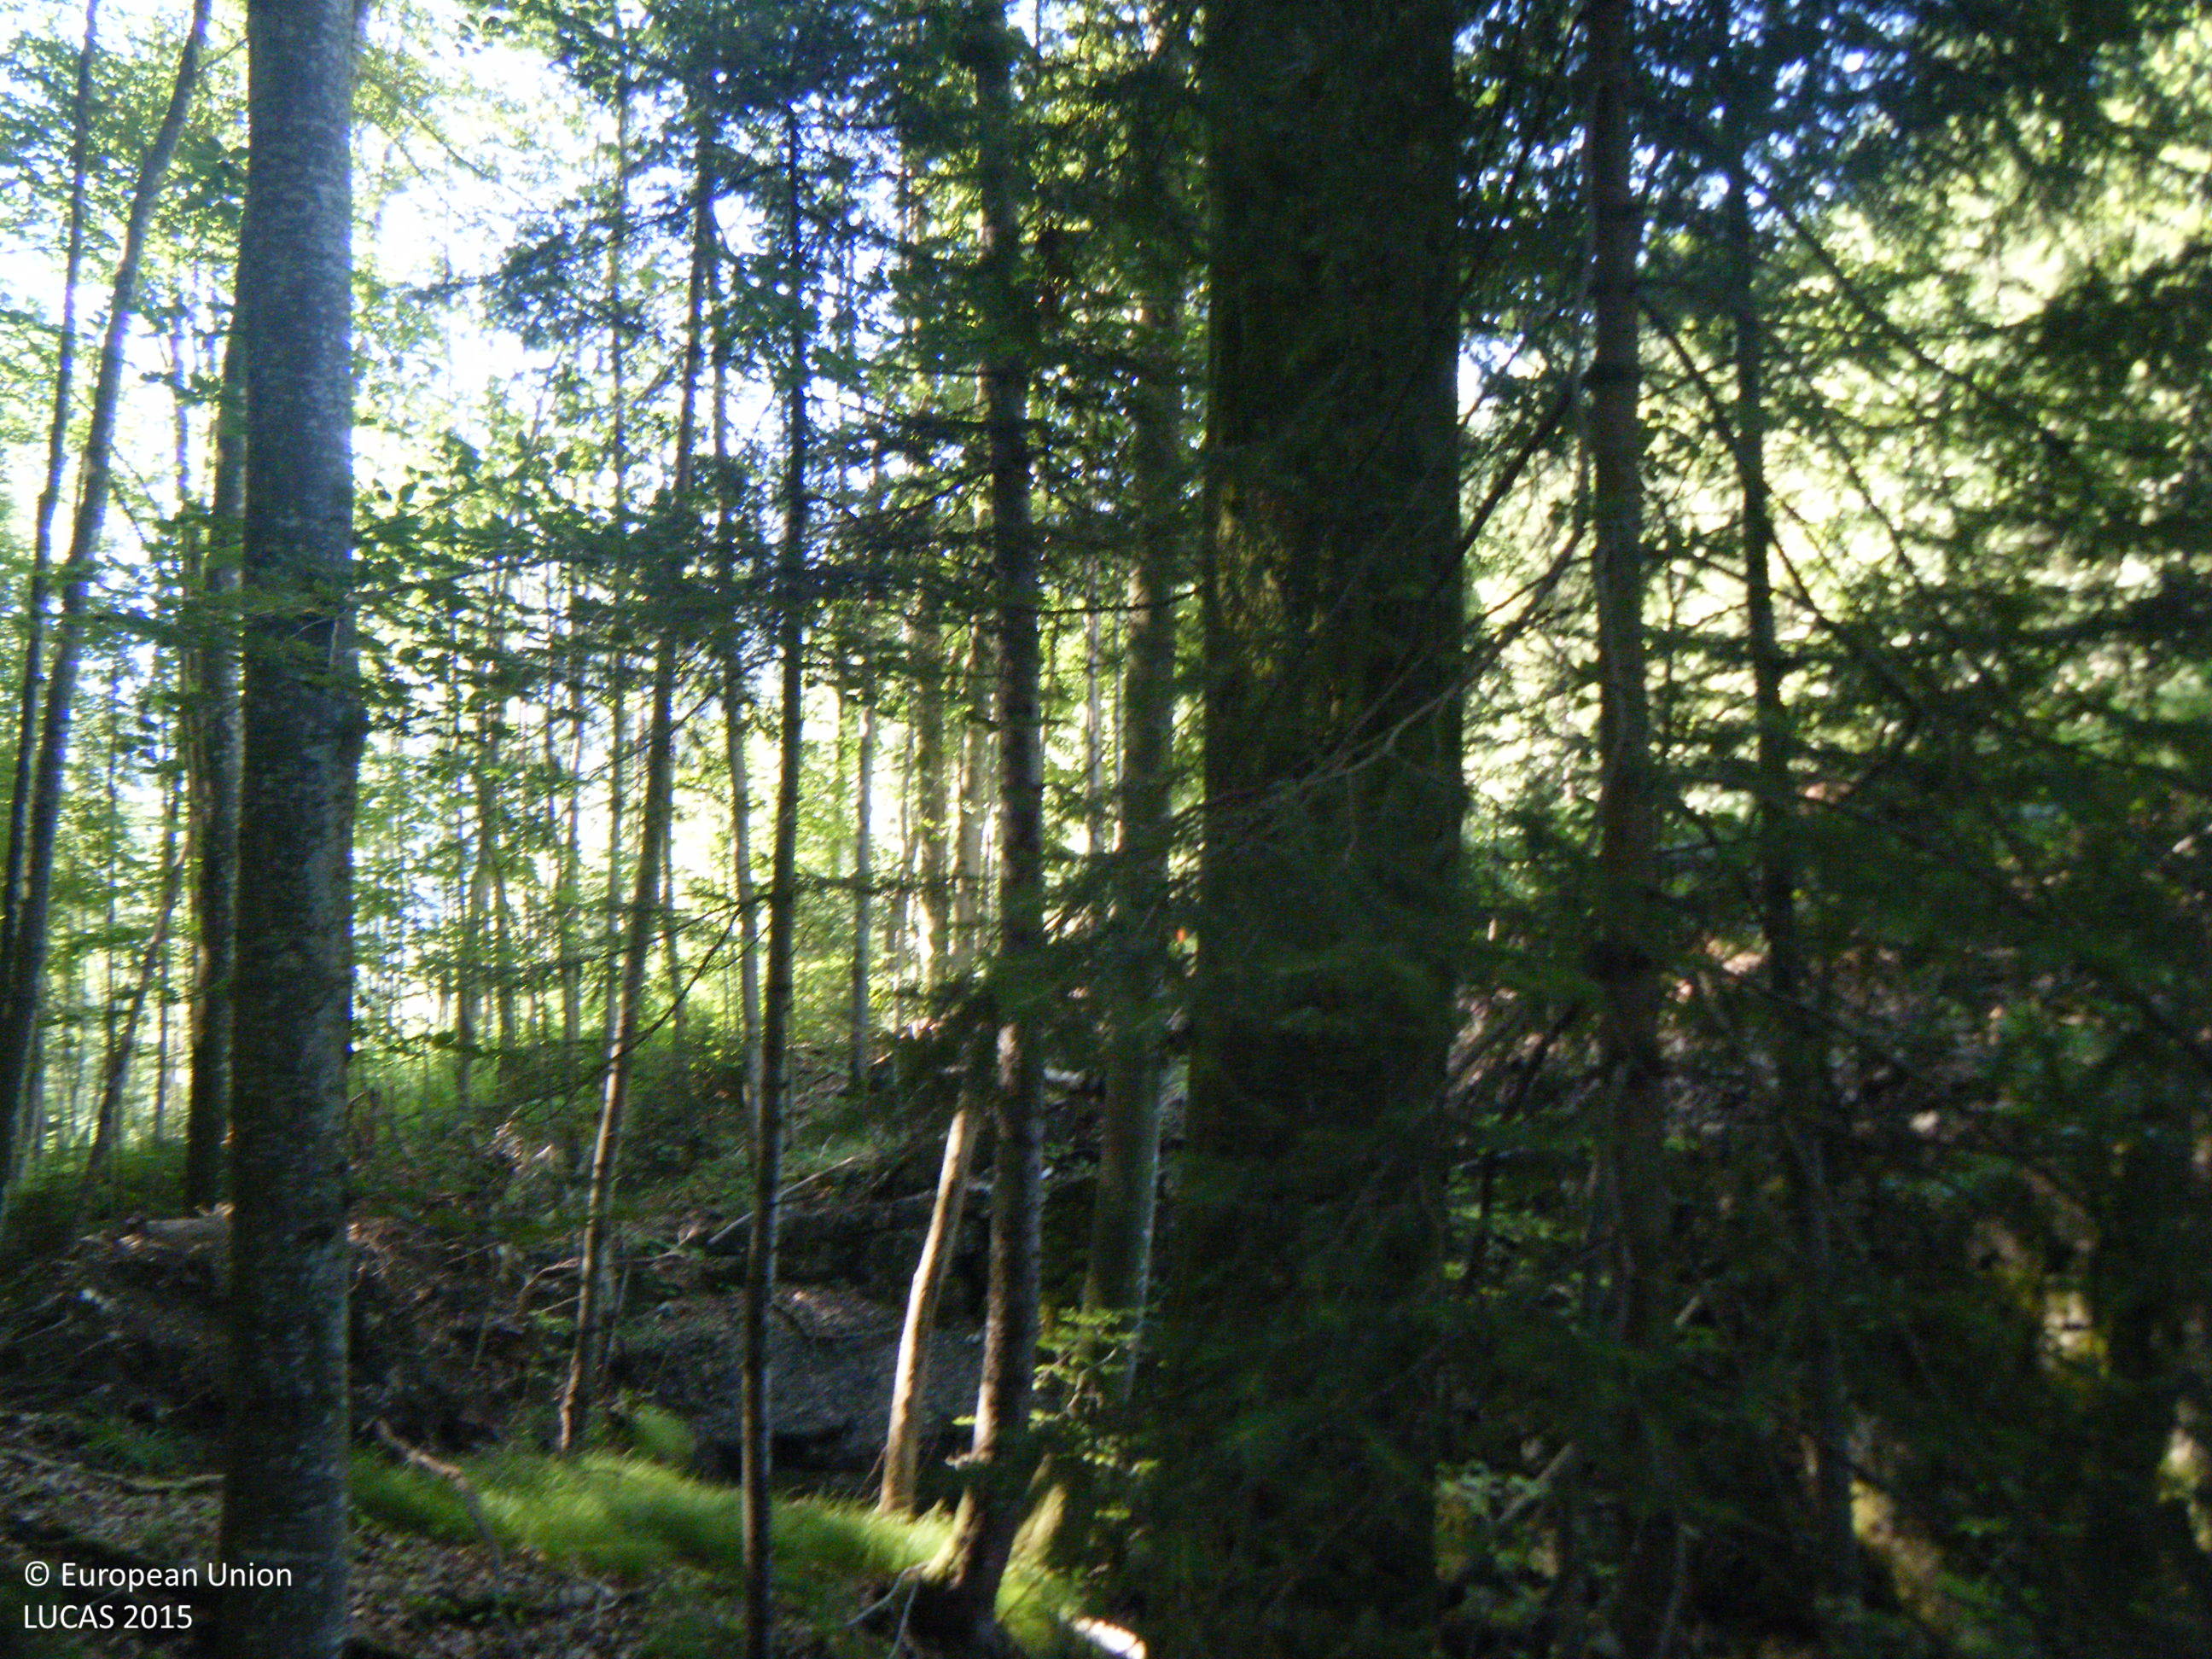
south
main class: Woodland
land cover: Broadleaved woodland
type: beech forest
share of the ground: > 75 %
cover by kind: broadleaved forest trees 70 %, coniferous forest trees 20 %, lichens and mosses 5 %, unconsolidated bare surface 5 %
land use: Forestry
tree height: > 5 m
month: July
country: AT
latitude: 47.7765
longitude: 13.3483
